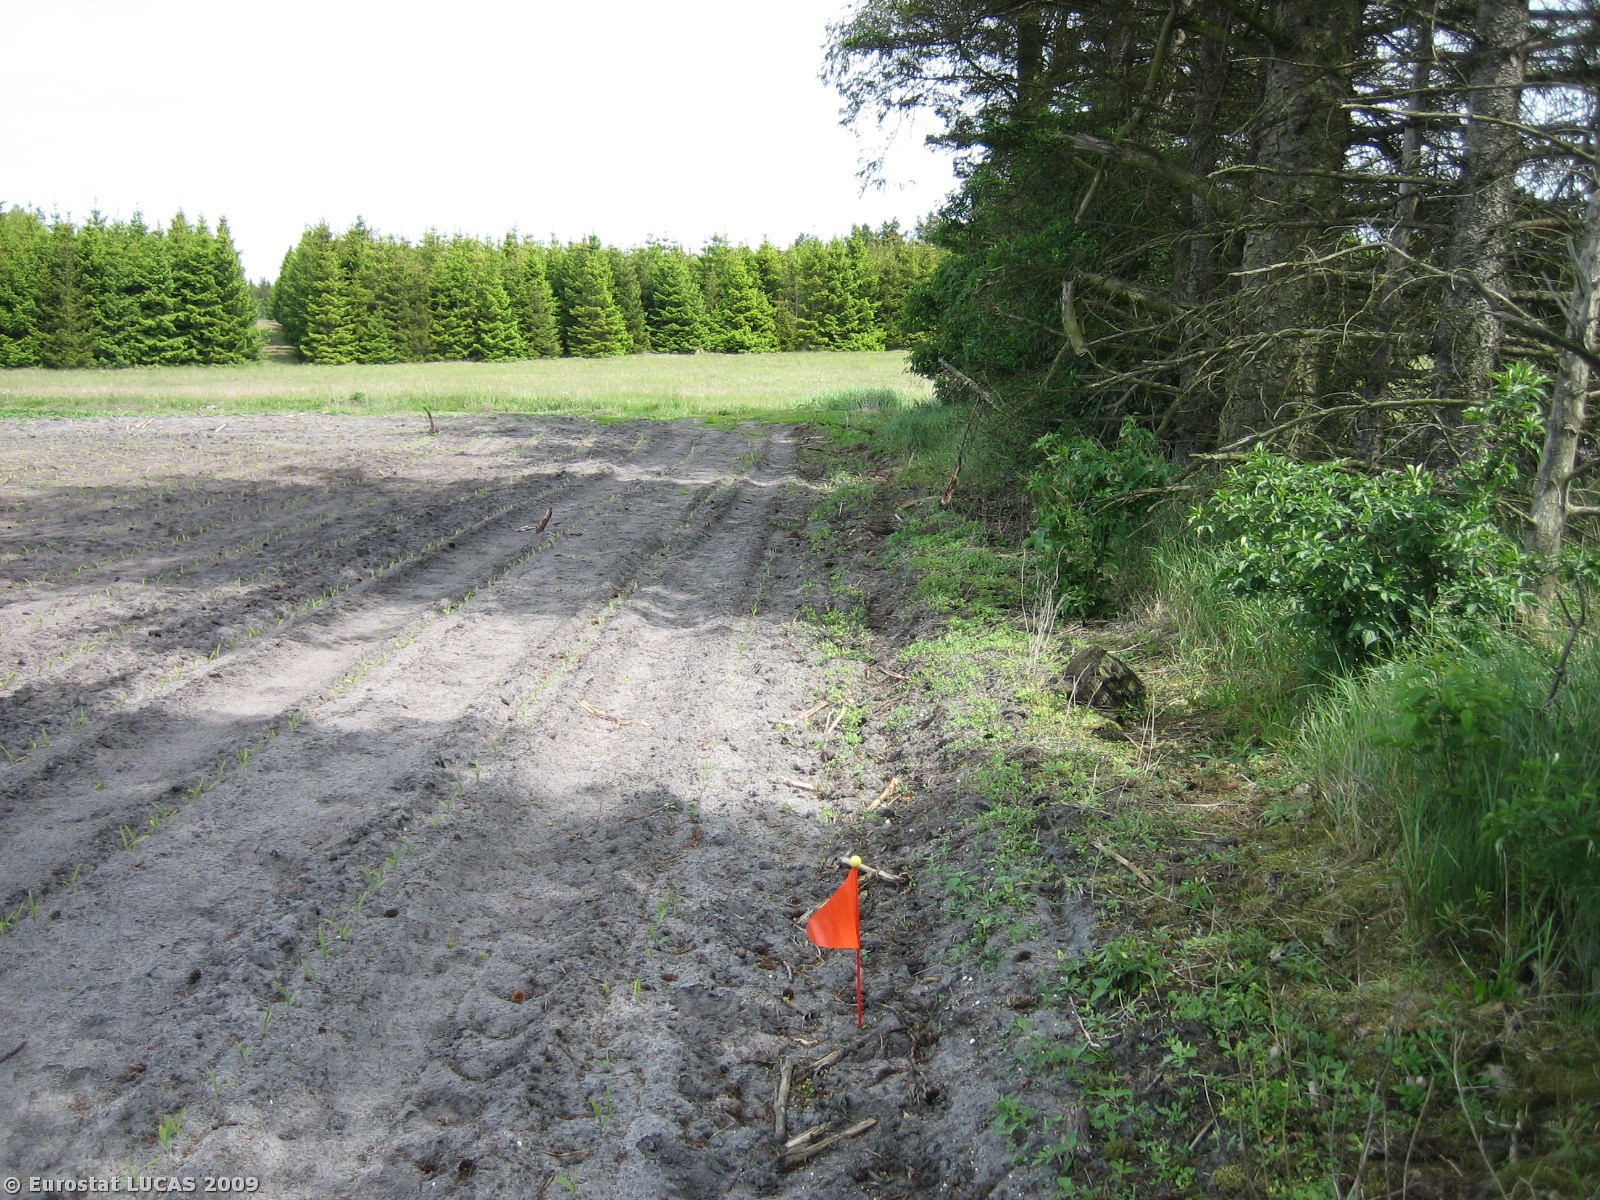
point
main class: Cropland
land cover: Maize
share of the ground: < 10 %
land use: Agriculture (excluding fallow land and kitchen gardens)
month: May
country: DK
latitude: 56.2932
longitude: 9.2093
